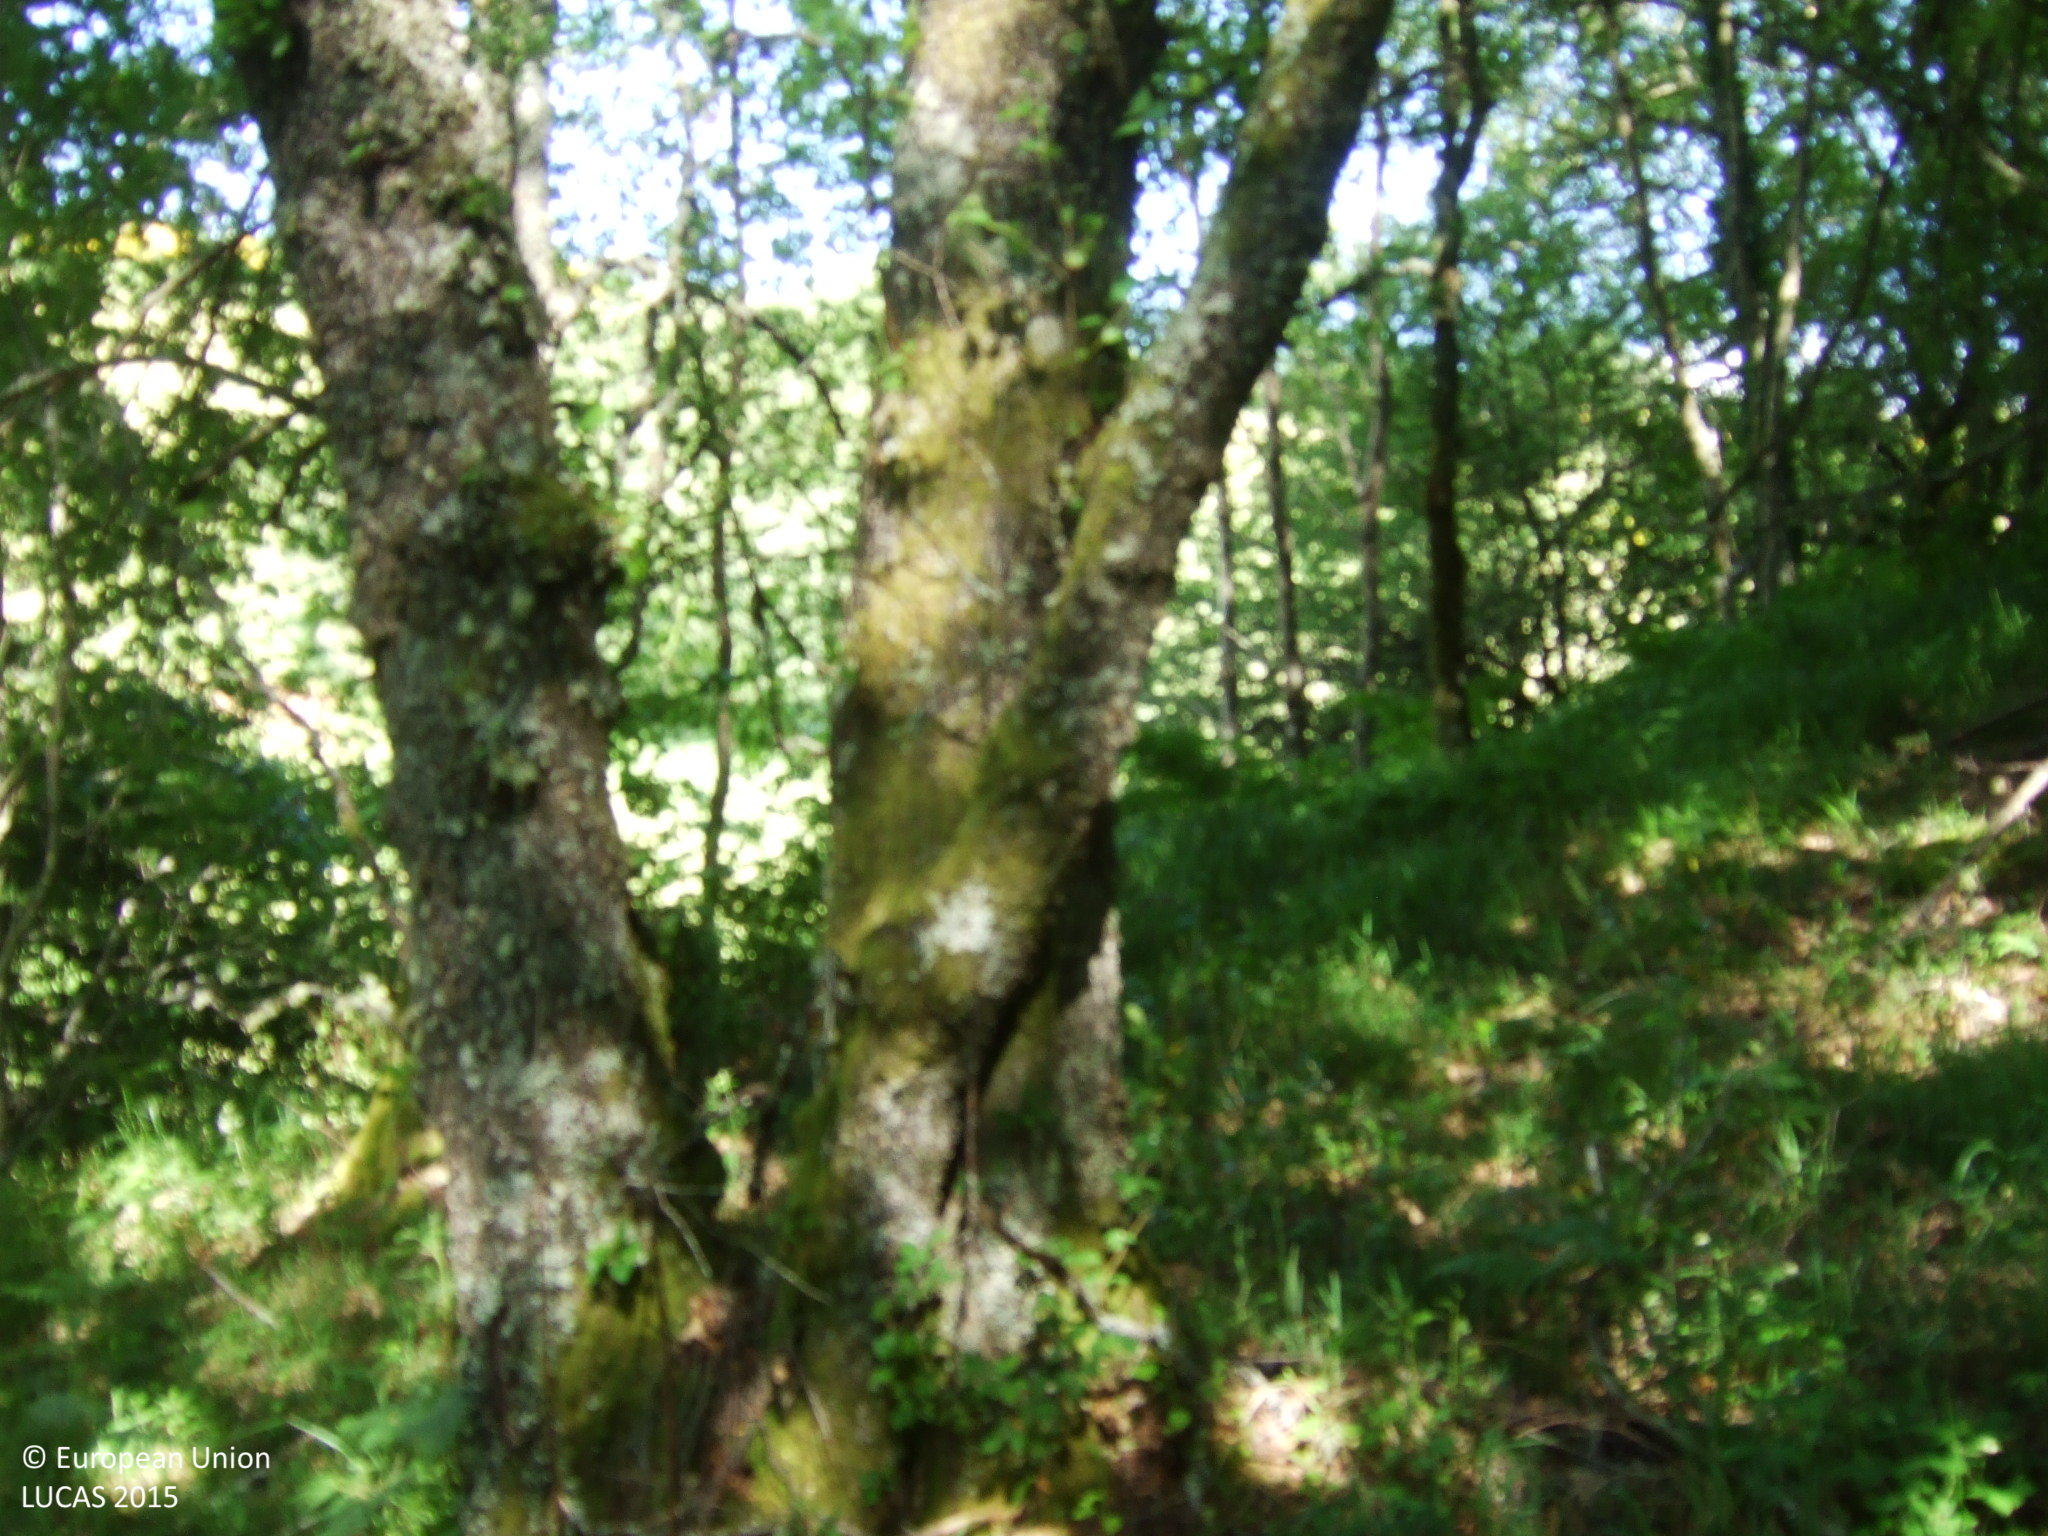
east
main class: Woodland
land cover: Broadleaved woodland
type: acidophilous oak and oak-birch forest
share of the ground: > 75 %
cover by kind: broadleaved forest trees 80 %, shrubs 20 %
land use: Semi-natural and natural areas not in use
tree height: > 5 m
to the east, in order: Broadleaved woodland; Grassland without tree/shrub cover; Abandoned hedges; Grassland without tree/shrub cover; Abandoned hedges; Grassland without tree/shrub cover; Dry stone walls; Tracks; Fences; Grassland without tree/shrub cover; Abandoned hedges; Other fresh vegetables; Other bare soil; Grassland without tree/shrub cover
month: June
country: ES
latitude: 42.6855
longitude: -7.0610
